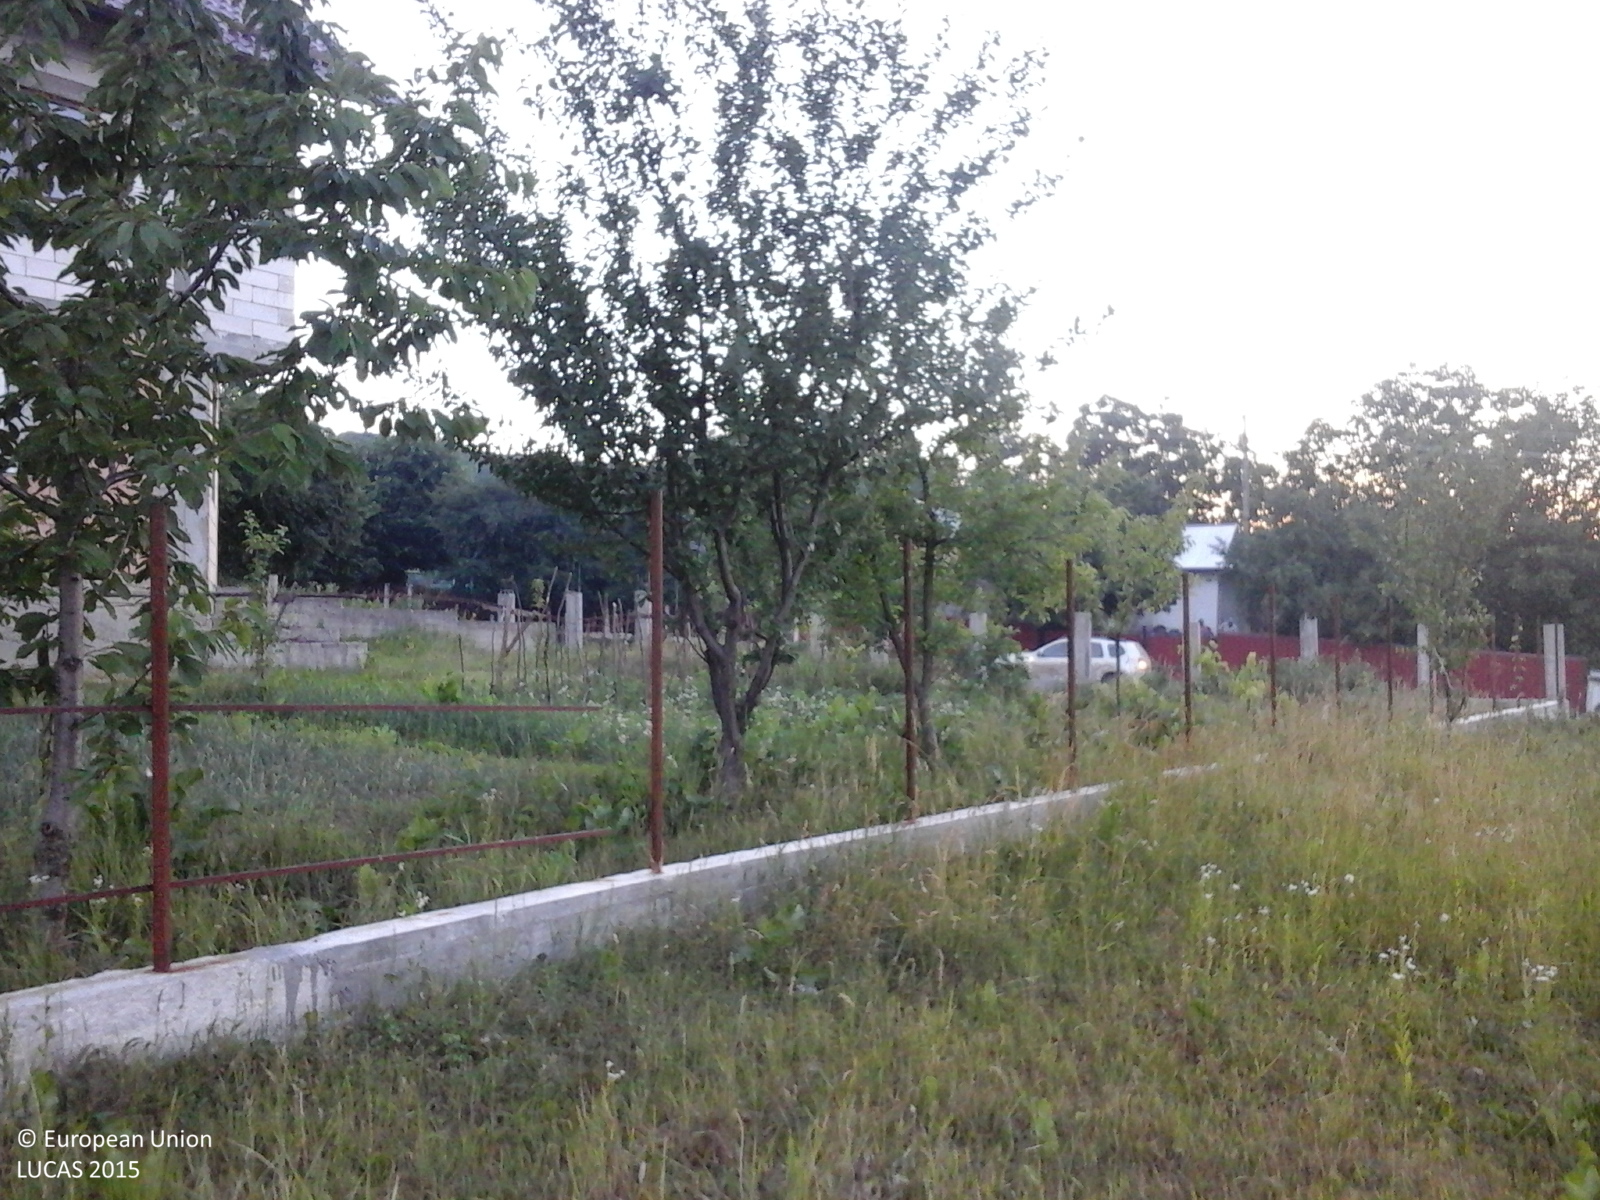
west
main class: Cropland
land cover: Apple fruit
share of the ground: > 75 %
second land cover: Grassland without tree/shrub cover
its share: > 75 %
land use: Kitchen garden
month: June
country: RO
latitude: 47.7358
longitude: 26.2864
